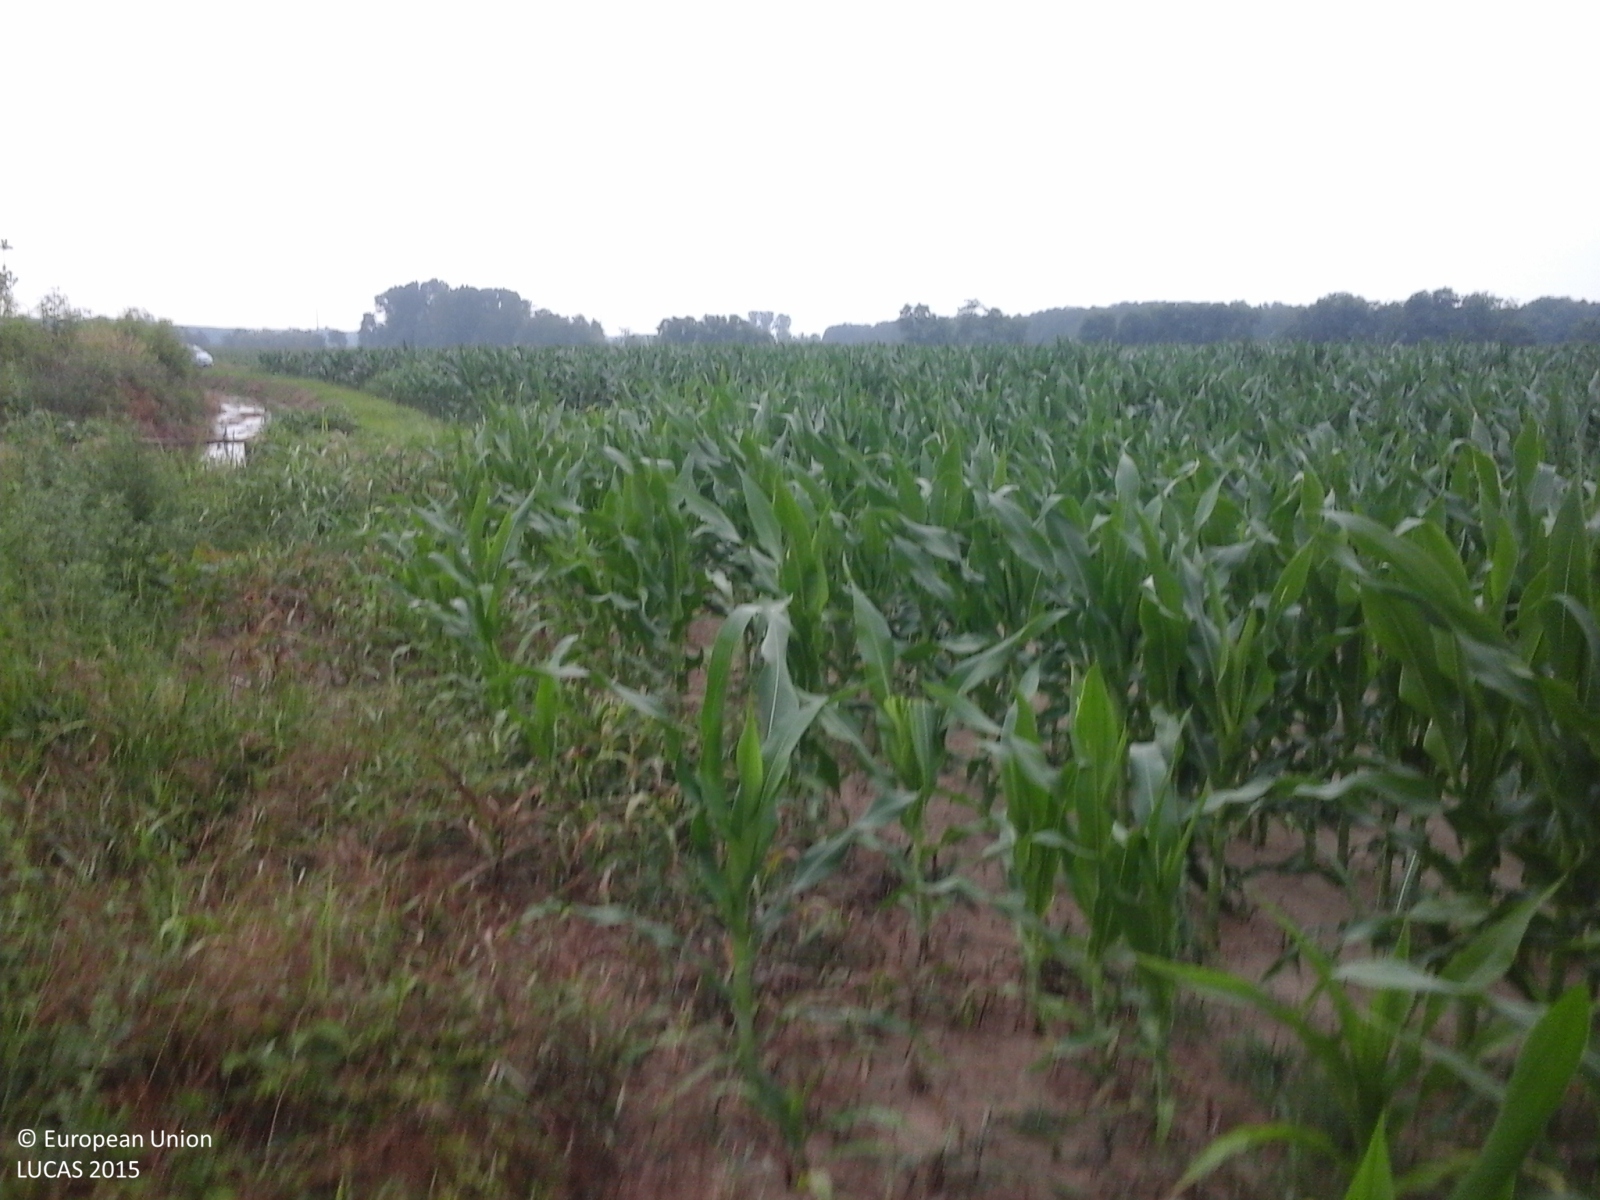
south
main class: Cropland
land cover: Maize
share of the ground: > 75 %
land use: Agriculture (excluding fallow land and kitchen gardens)
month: June
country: IT
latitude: 45.2271
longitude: 8.7922
